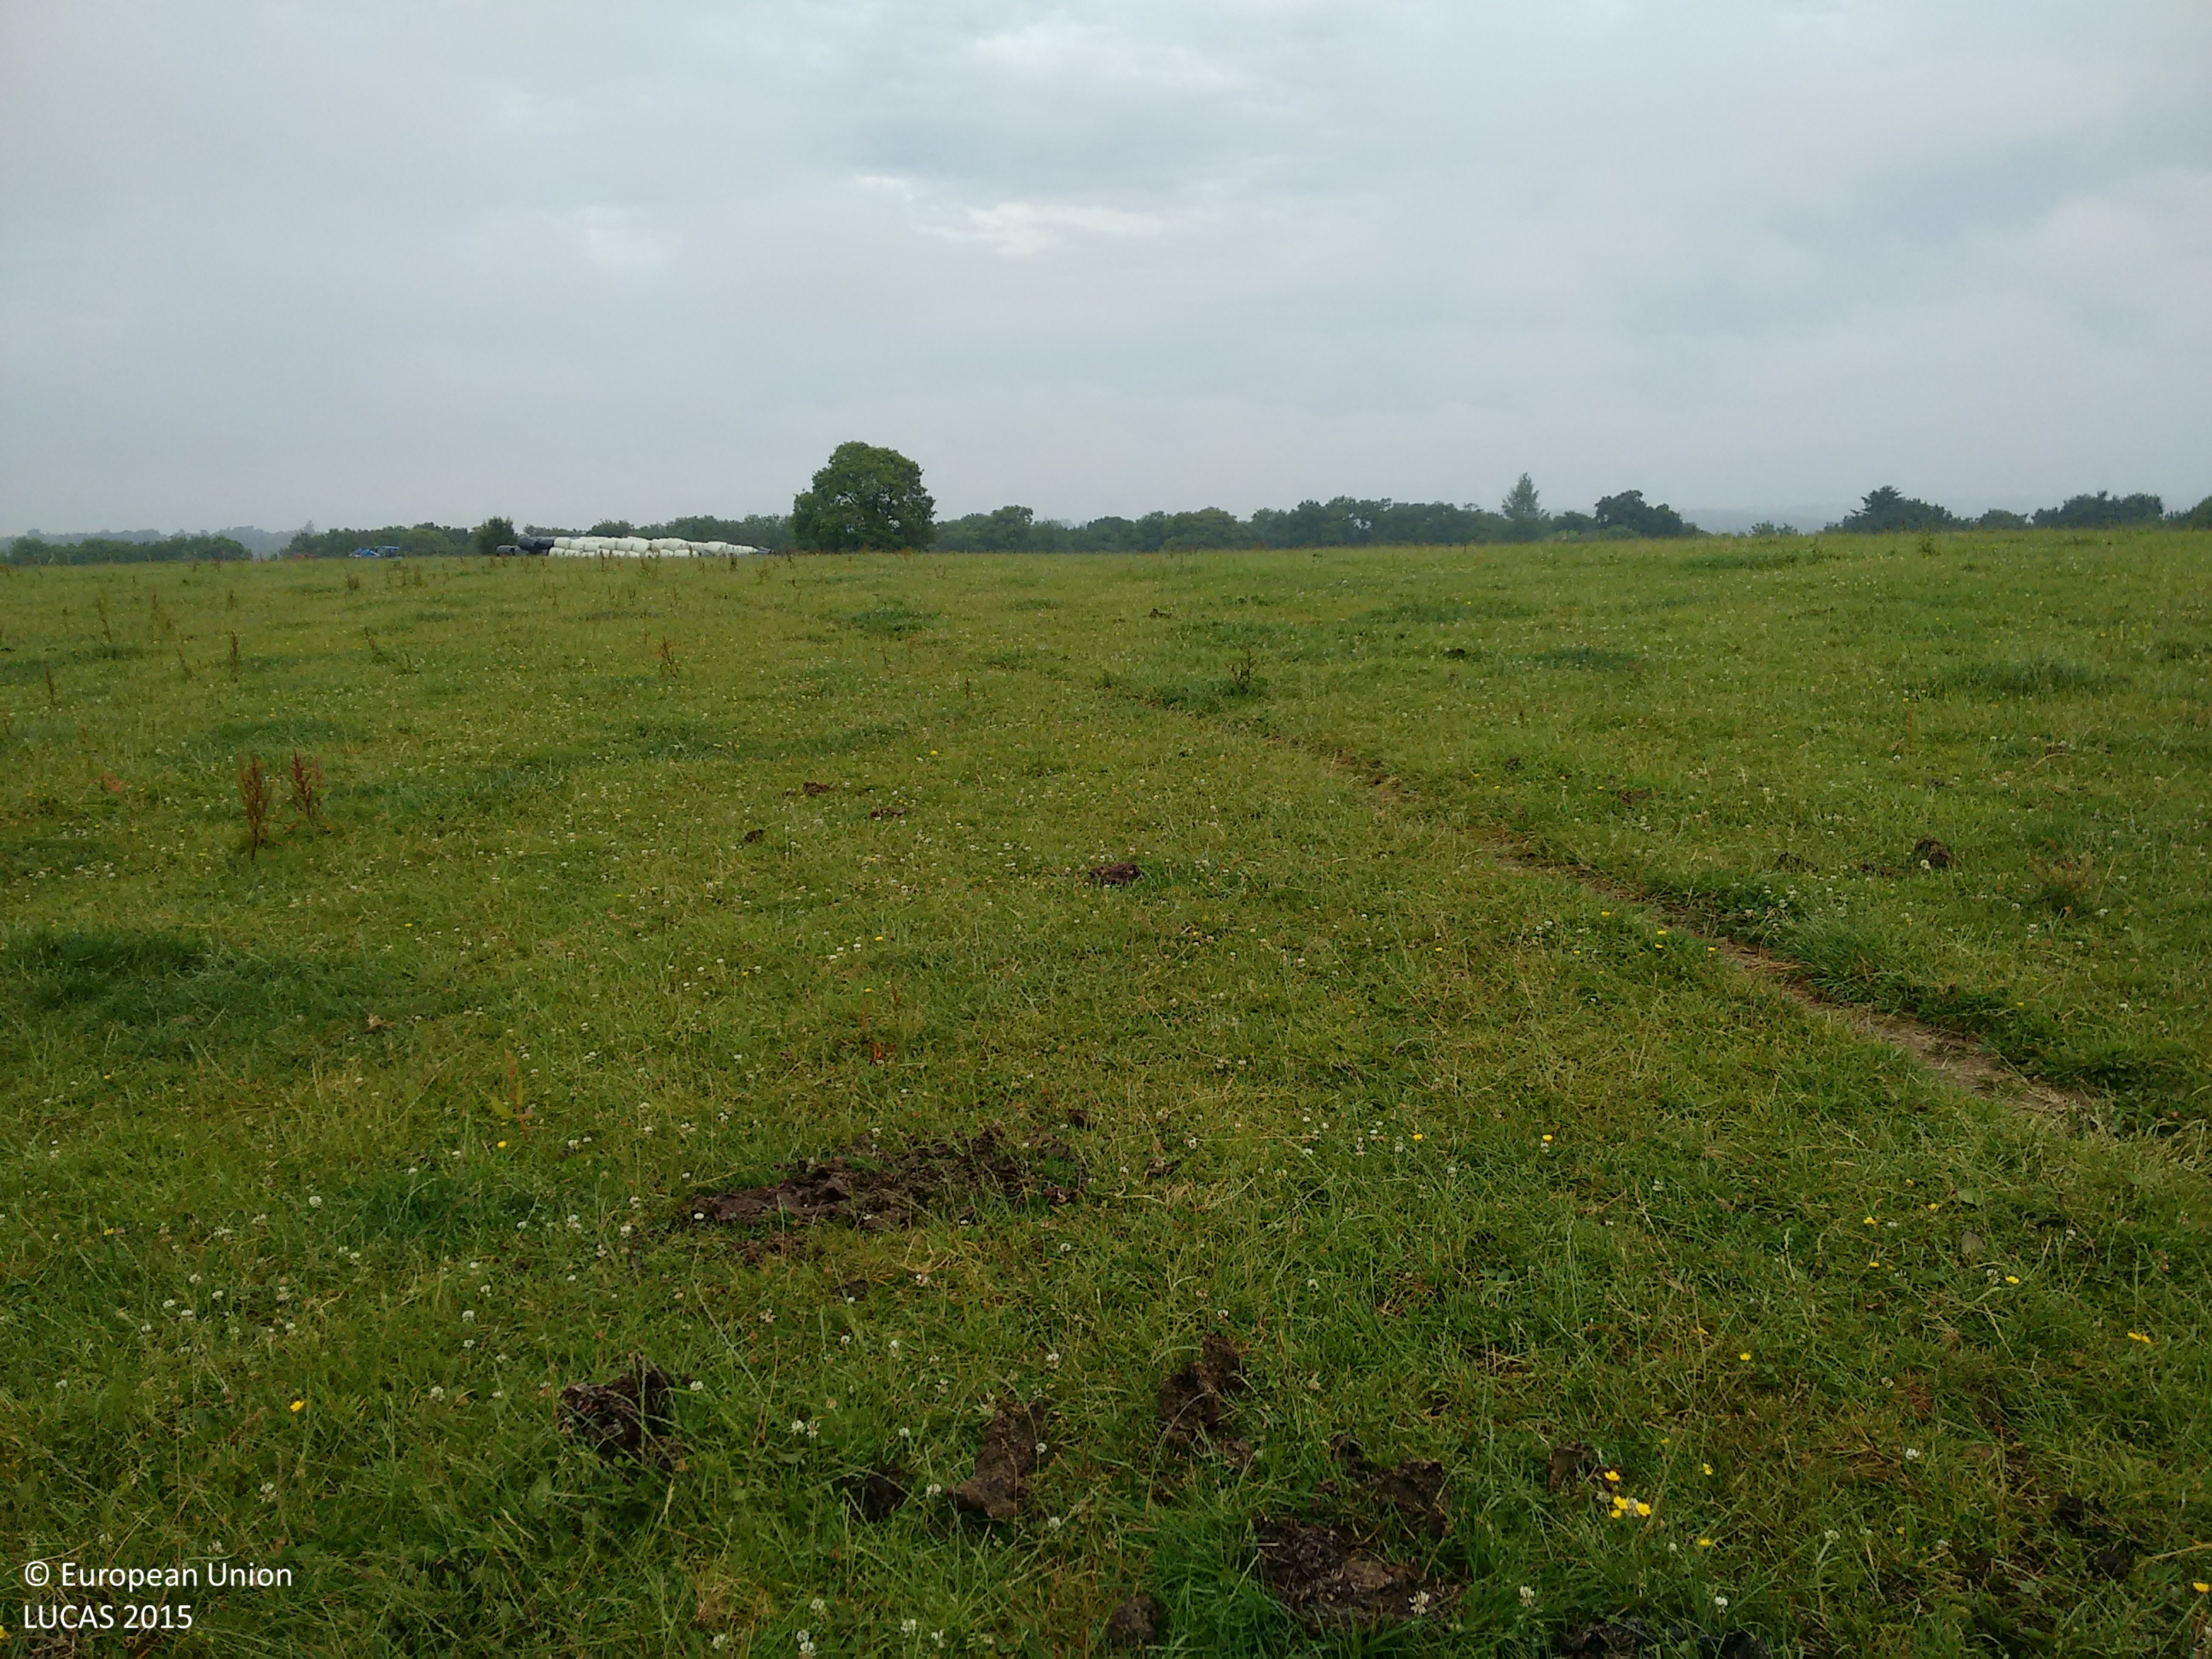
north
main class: Grassland
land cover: Grassland without tree/shrub cover
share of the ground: > 75 %
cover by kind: herbaceous plants 100 %
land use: Agriculture (excluding fallow land and kitchen gardens)
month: July
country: GB
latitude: 51.0533
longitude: -0.1491
